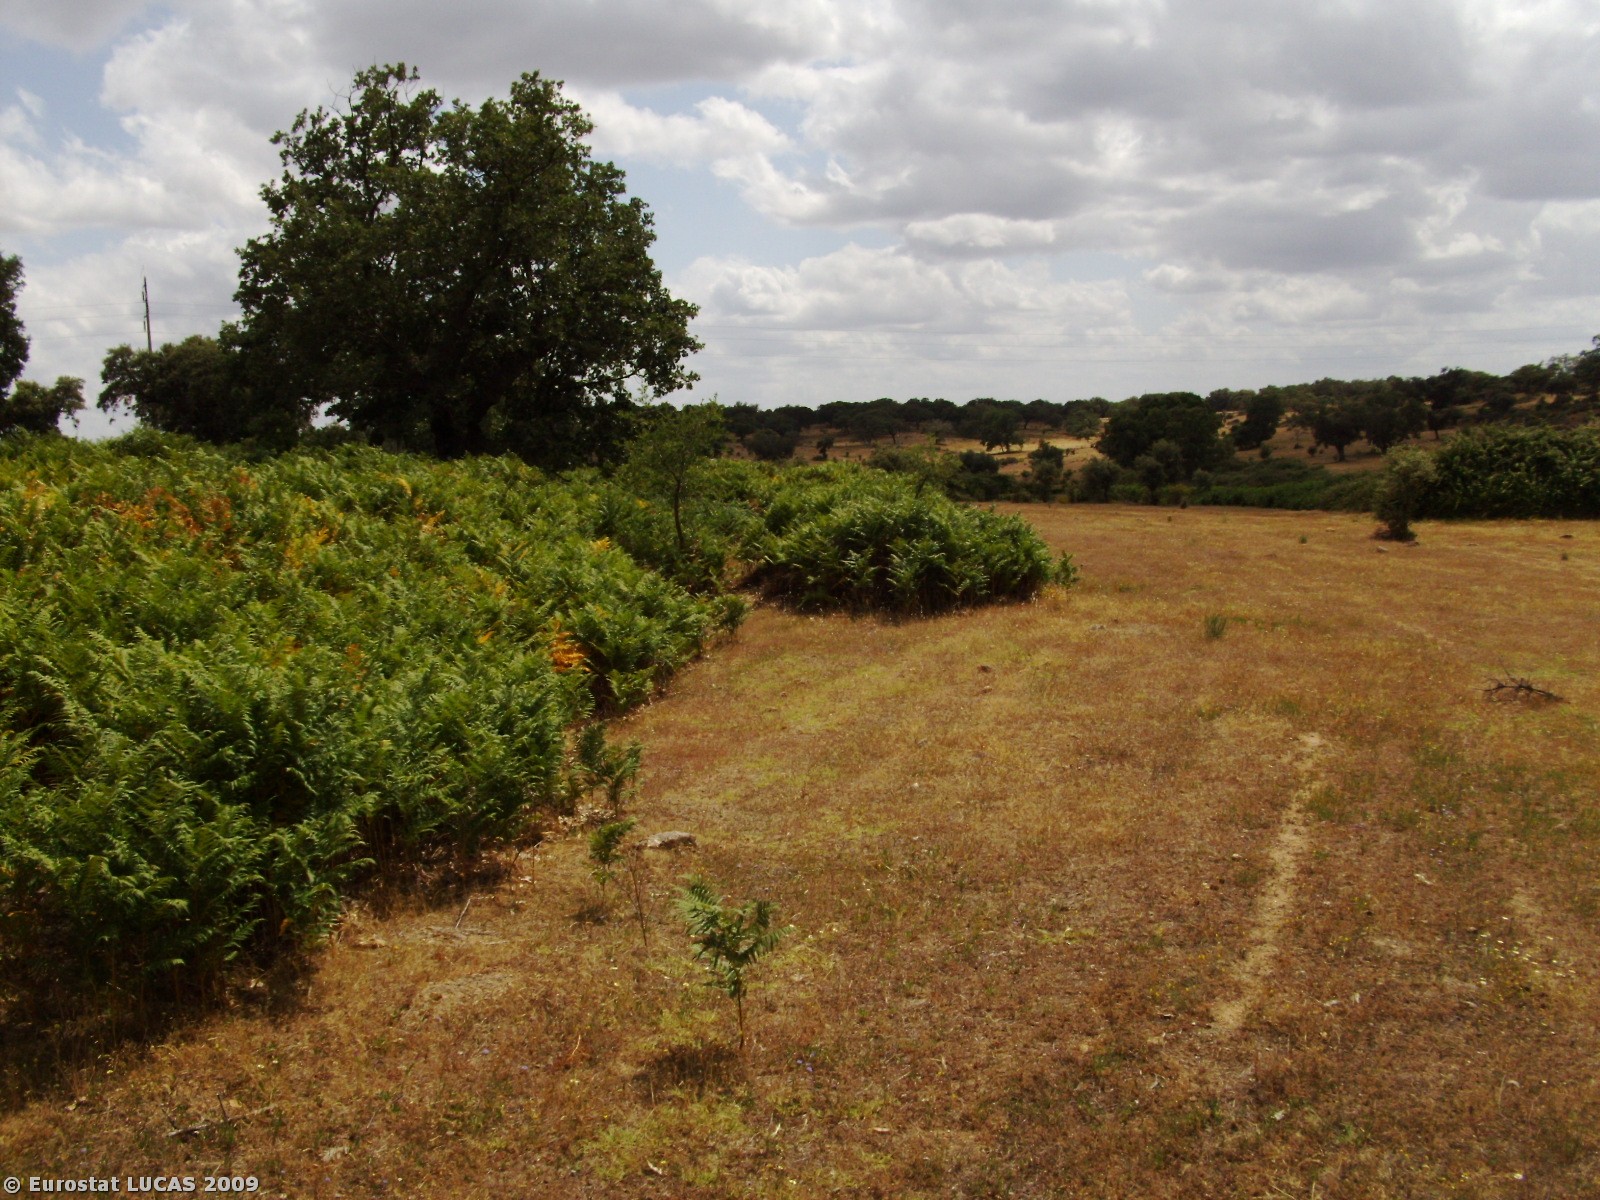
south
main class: Woodland
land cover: Broadleaved woodland
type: broadleaved evergreen forest
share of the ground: 10 - 25 %
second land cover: Spontaneously vegetated surfaces
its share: > 75 %
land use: Forestry
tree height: > 5 m
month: June
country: PT
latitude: 39.8599
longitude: -7.4097
